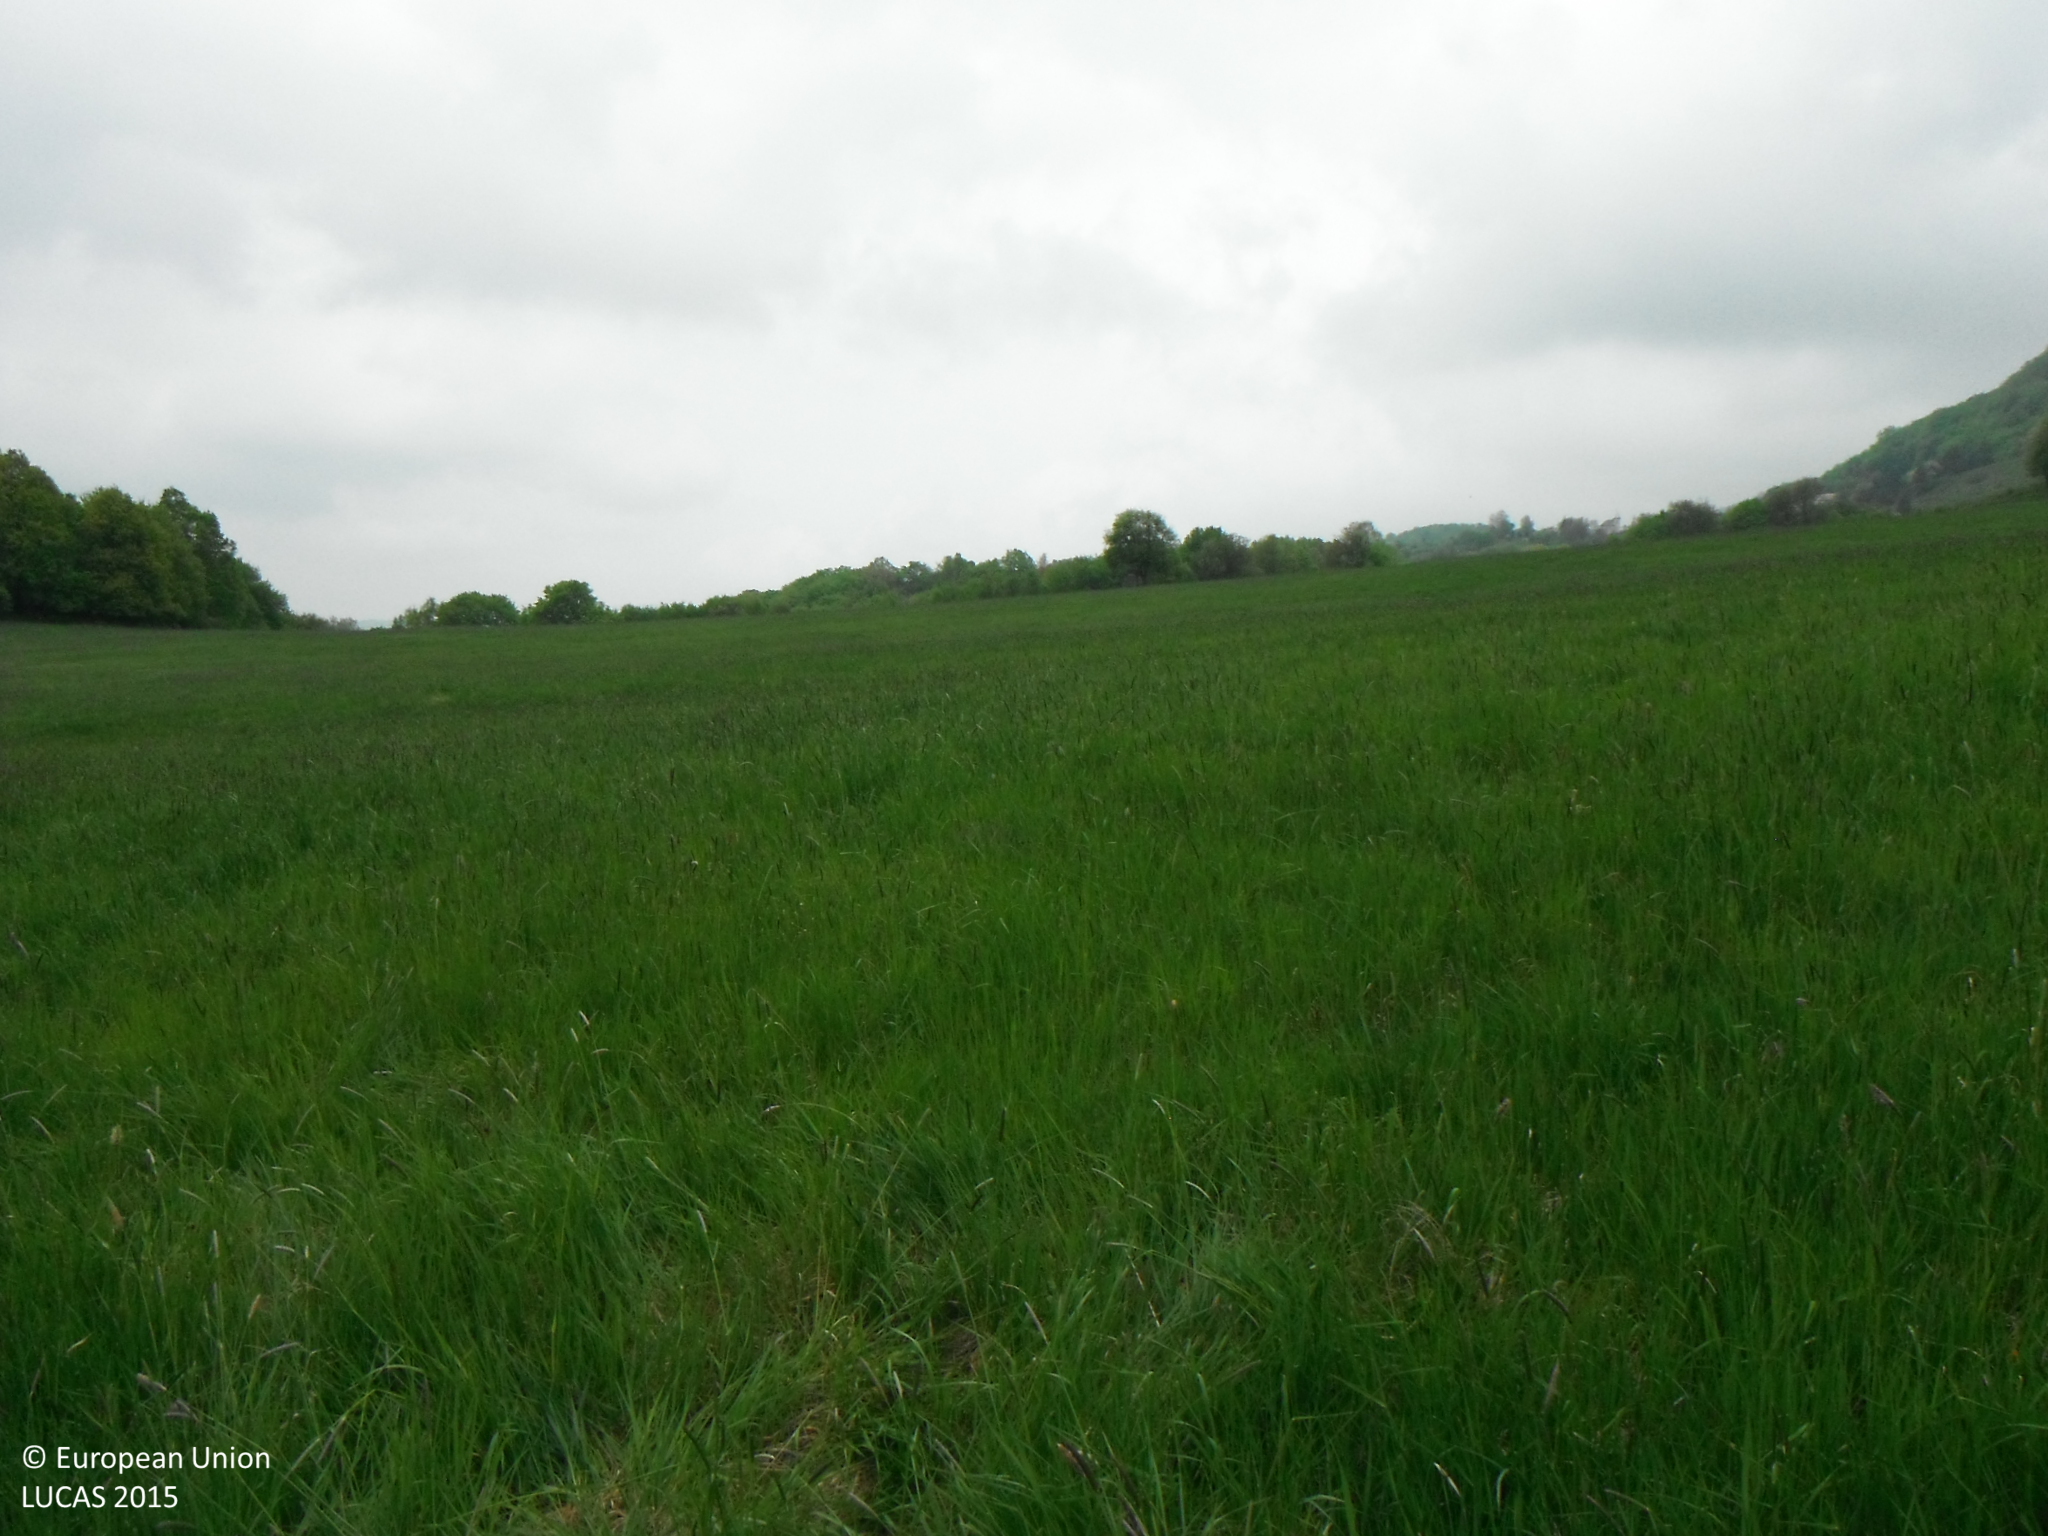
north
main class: Grassland
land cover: Grassland without tree/shrub cover
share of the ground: > 75 %
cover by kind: herbaceous plants 100 %
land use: Agriculture (excluding fallow land and kitchen gardens)
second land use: Other primary production
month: May
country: SK
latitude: 48.6005
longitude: 18.9569
